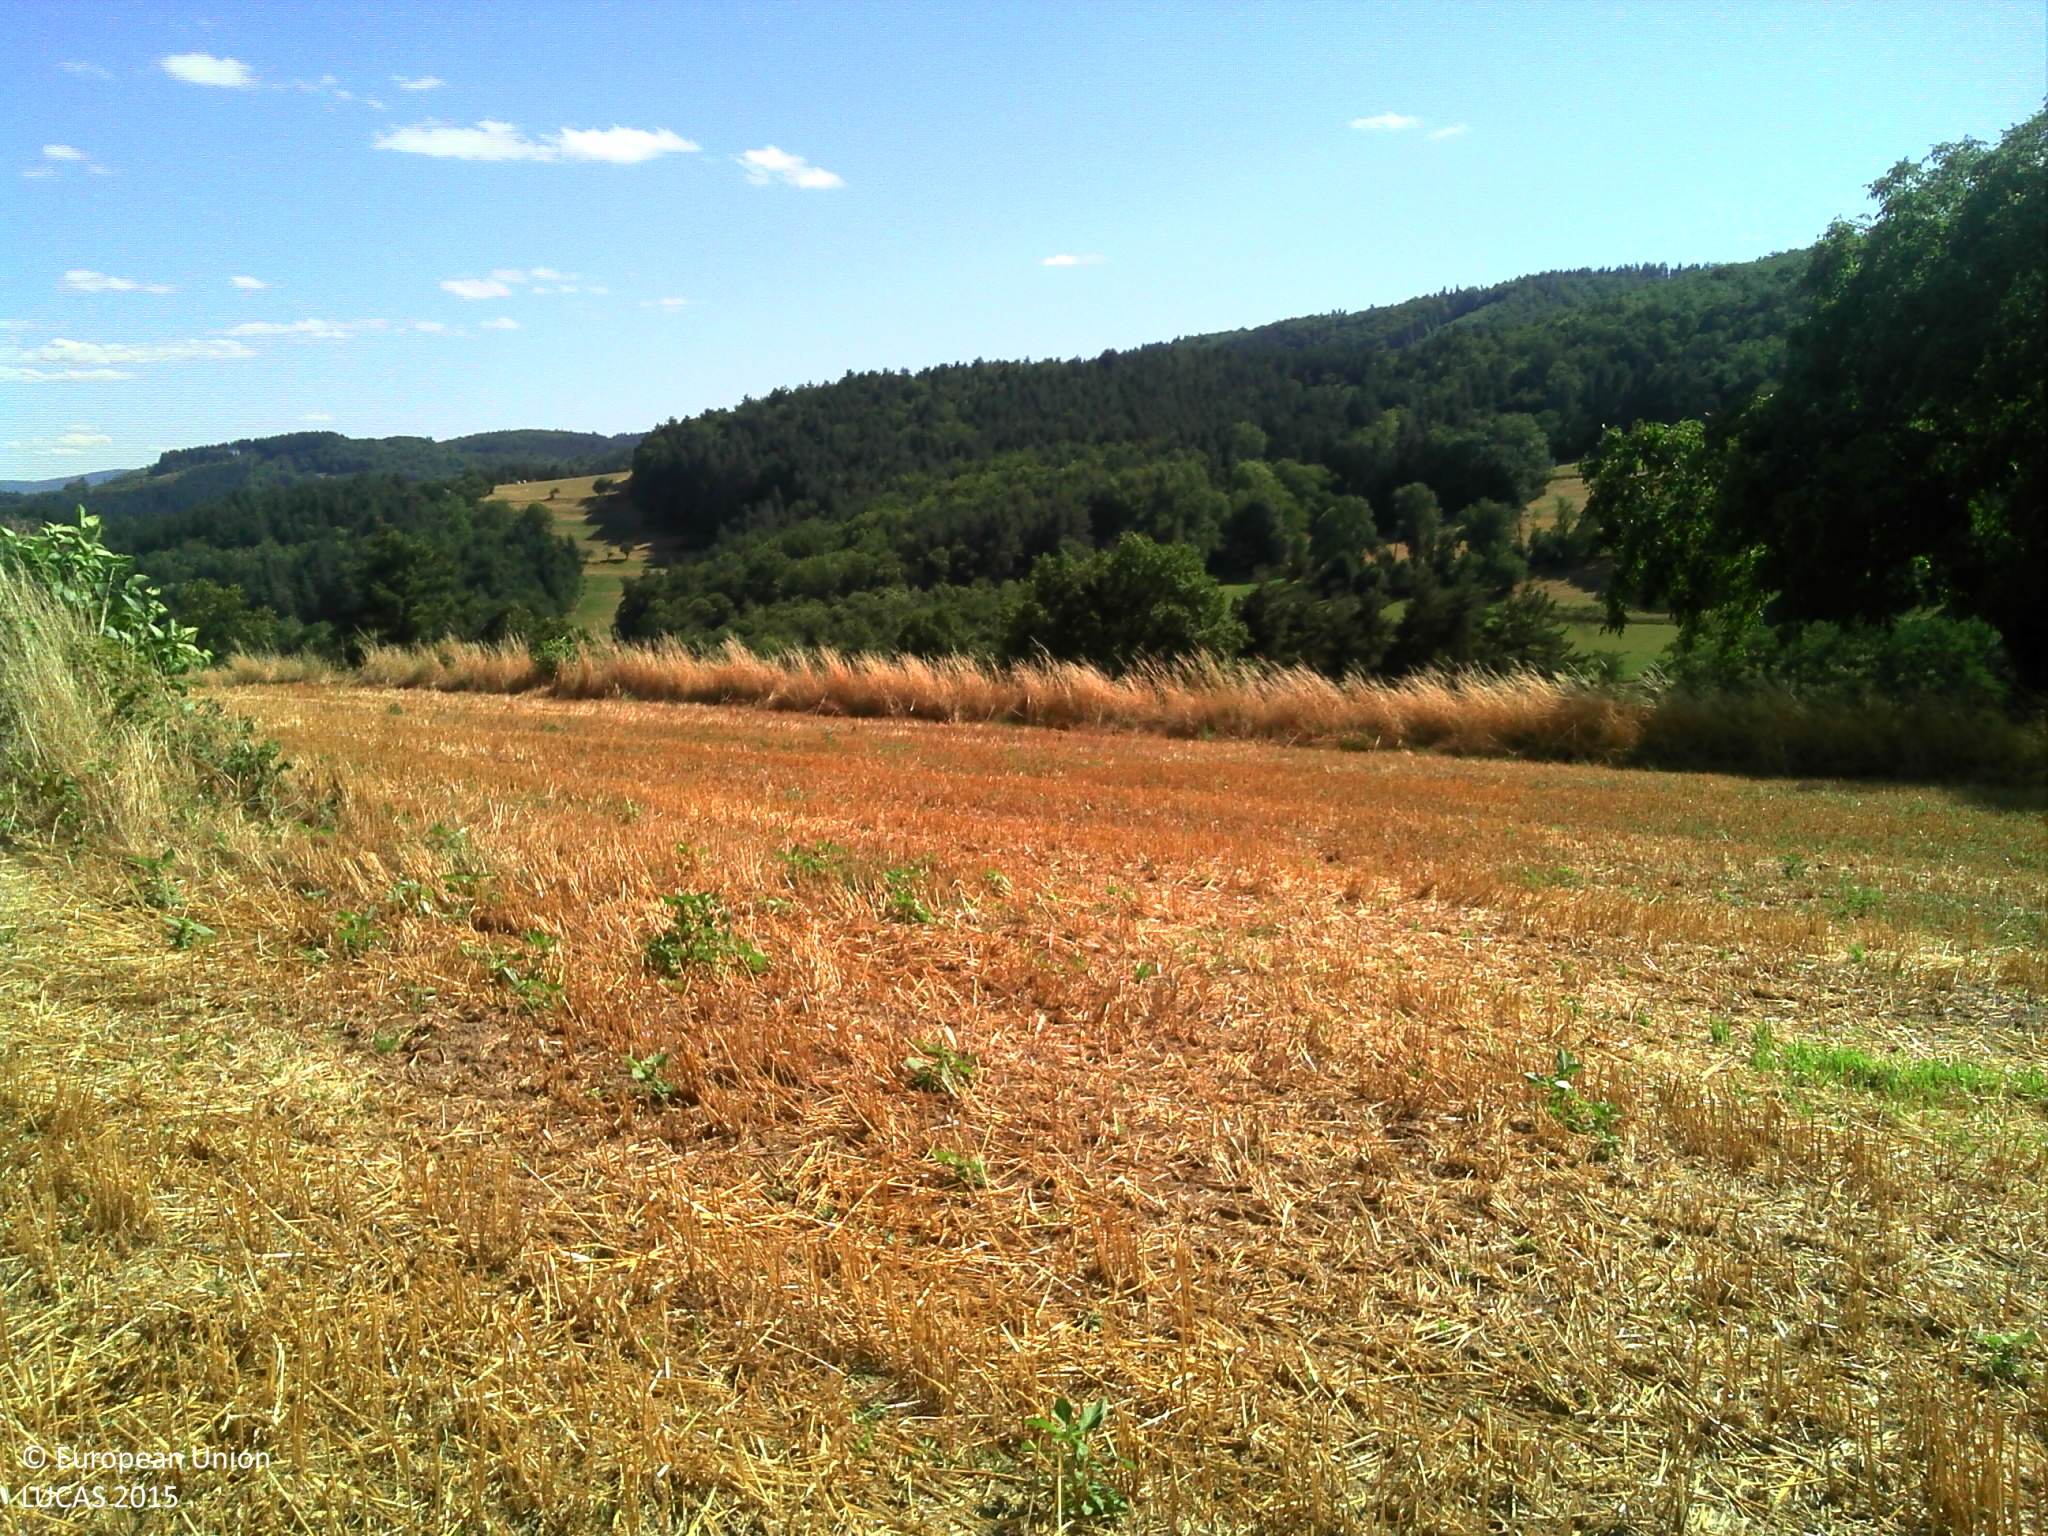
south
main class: Cropland
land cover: Barley
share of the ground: > 75 %
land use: Agriculture (excluding fallow land and kitchen gardens)
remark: Harvested field
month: July
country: FR
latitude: 44.9145
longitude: 4.5967
